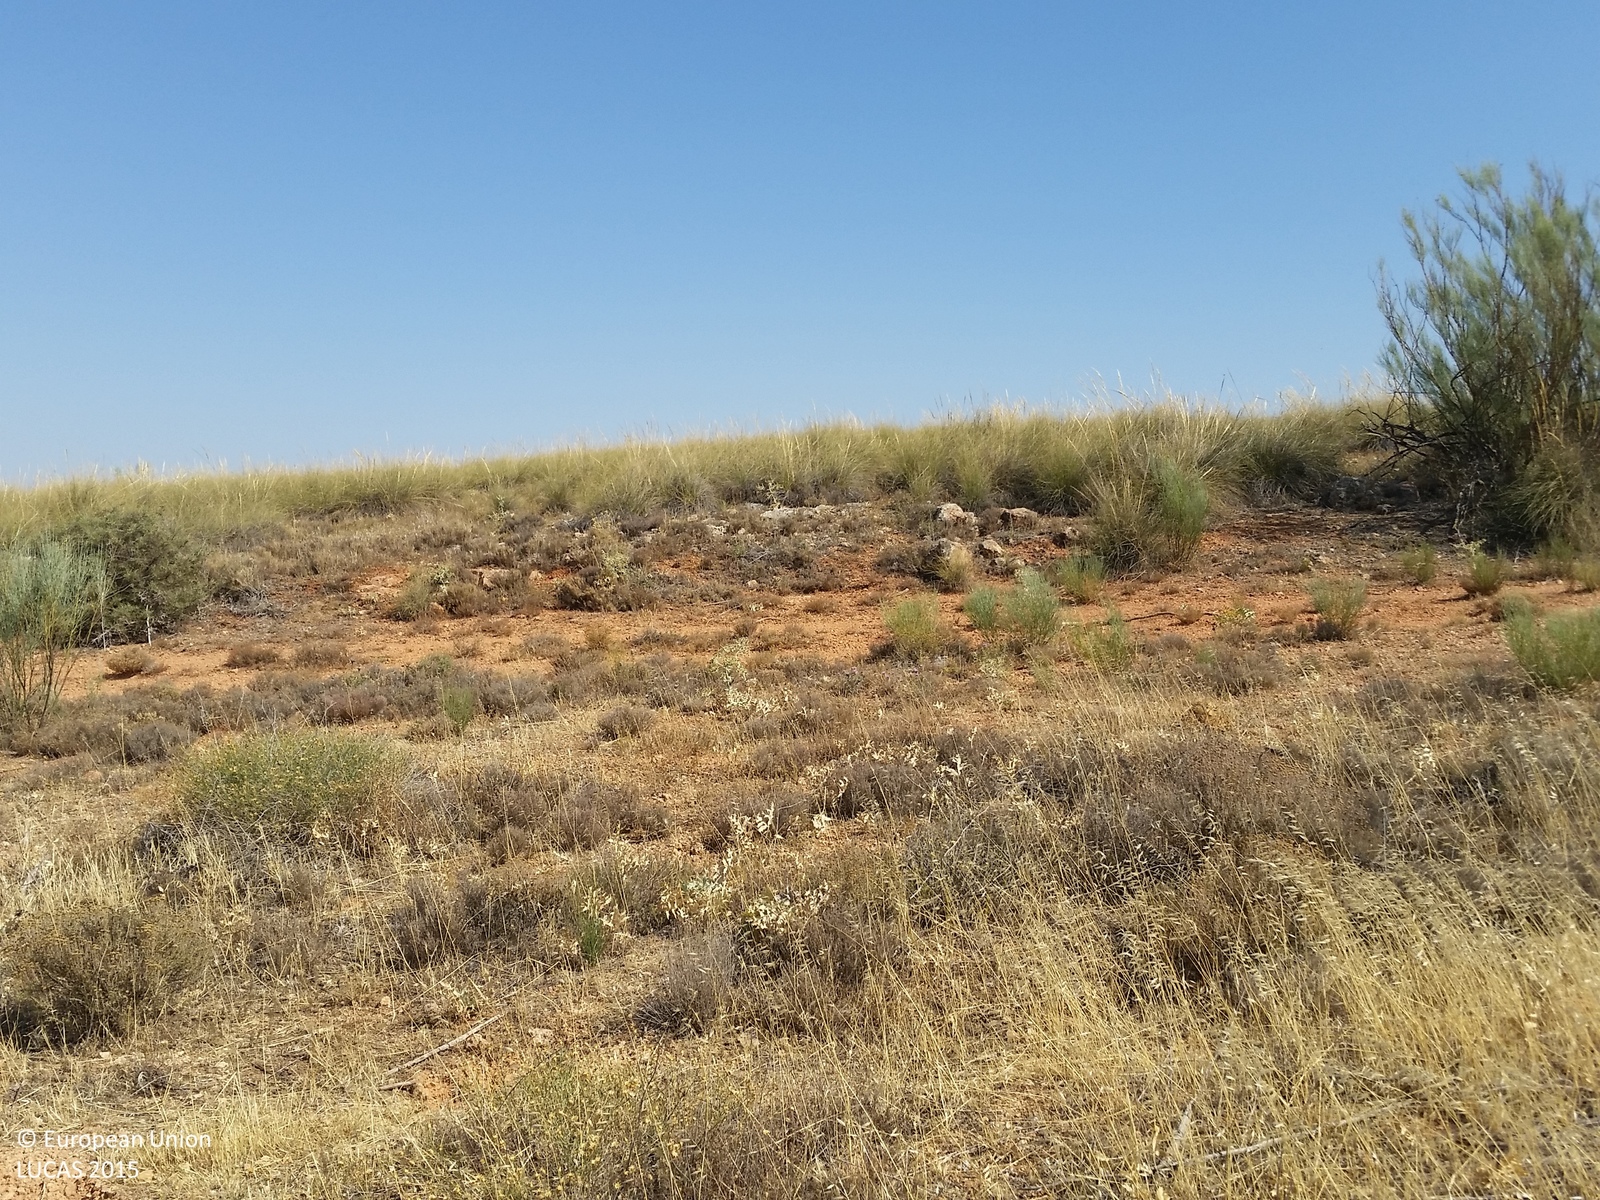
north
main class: Grassland
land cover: Spontaneously vegetated surfaces
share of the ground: > 75 %
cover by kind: herbaceous plants 70 %, consolidated bare surface 25 %, shrubs 5 %
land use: Semi-natural and natural areas not in use
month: July
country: ES
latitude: 39.2198
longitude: -2.5530
